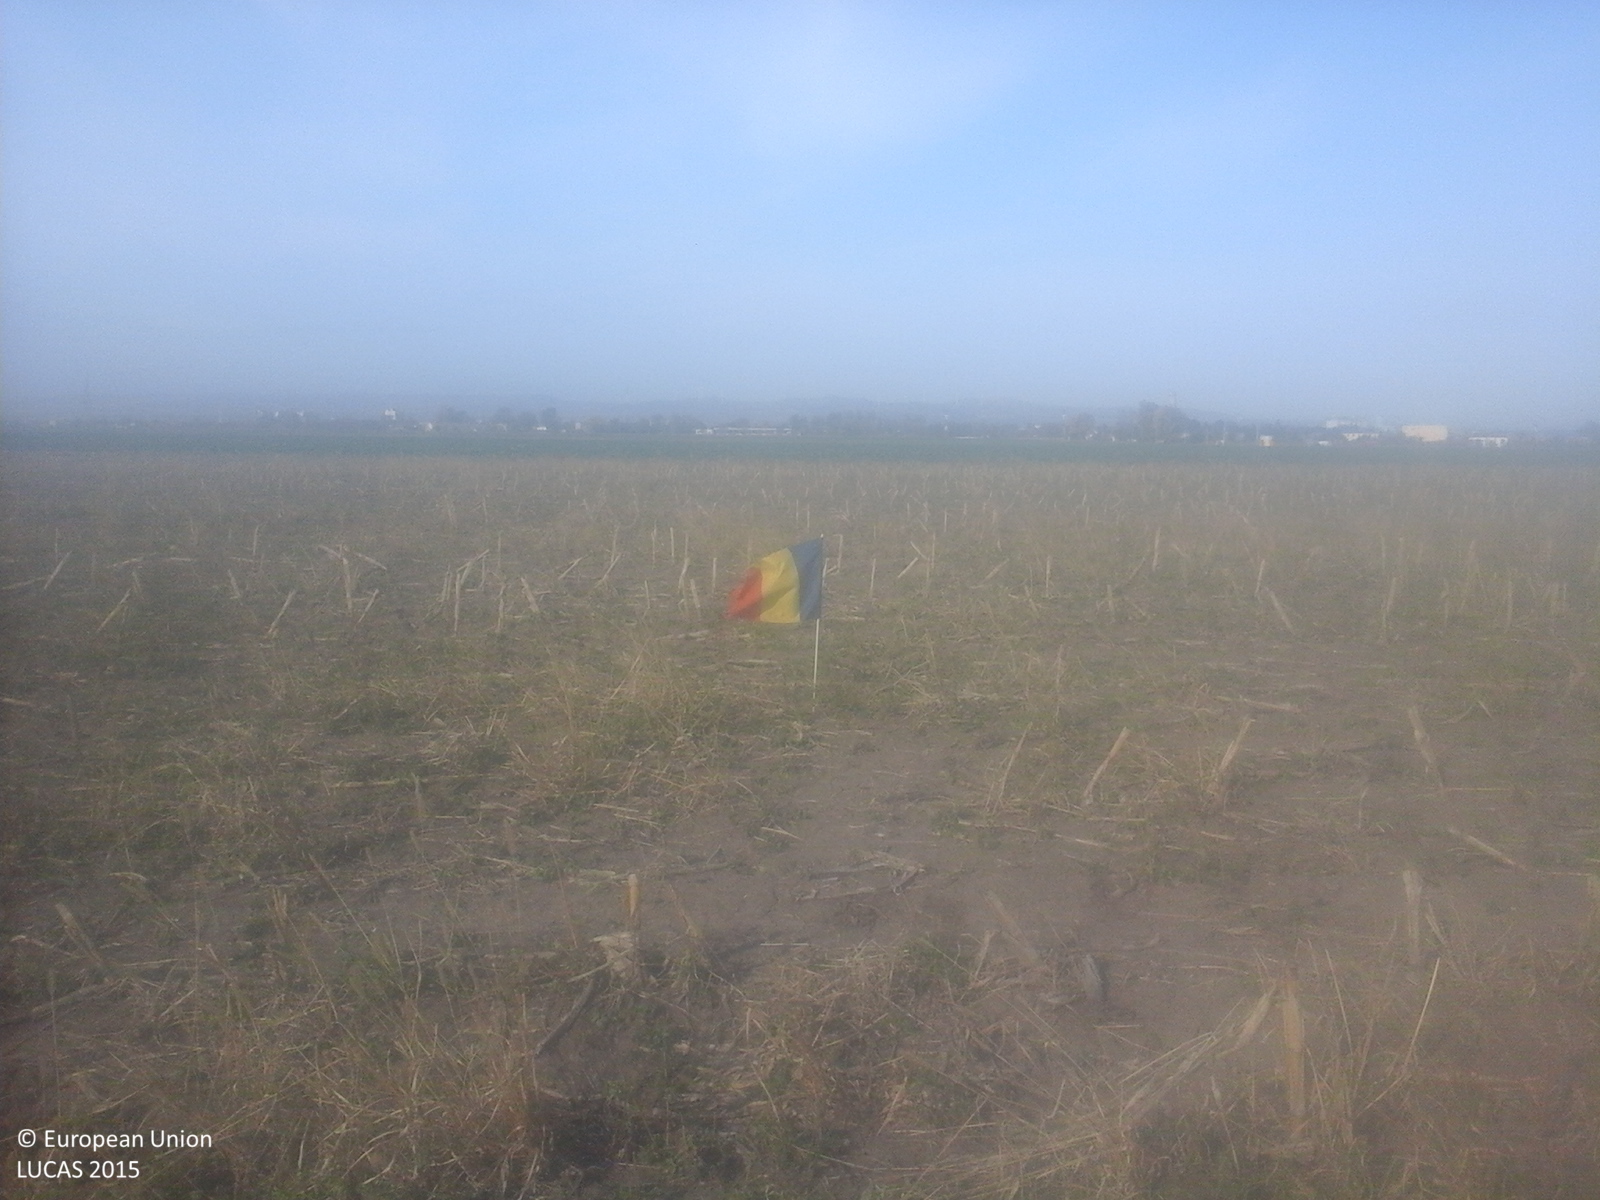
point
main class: Cropland
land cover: Maize
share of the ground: 10 - 25 %
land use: Agriculture (excluding fallow land and kitchen gardens)
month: October
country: RO
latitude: 45.3685
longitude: 27.0832
